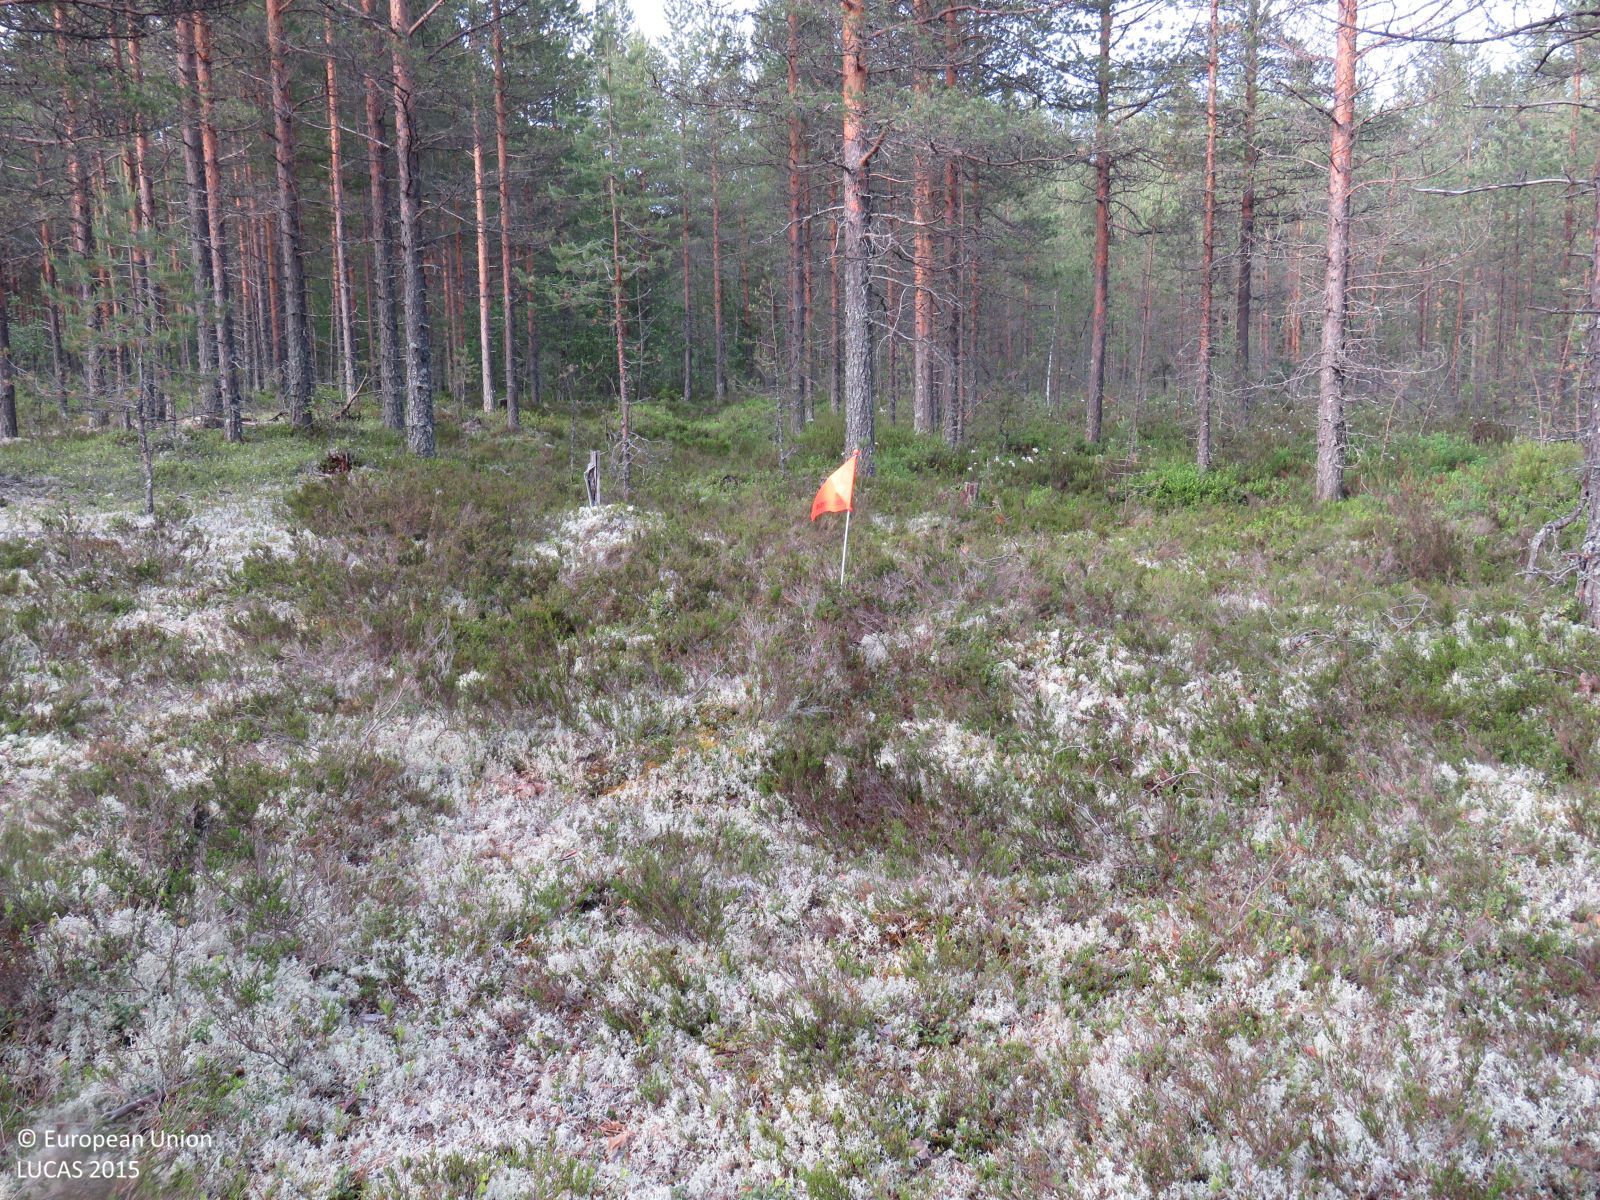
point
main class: Woodland
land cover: Pine dominated coniferous woodland
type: boreal forest
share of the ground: 25 - 50 %
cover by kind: coniferous forest trees 40 %, shrubs 40 %, lichens and mosses 20 %
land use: Forestry
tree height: > 5 m
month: June
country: FI
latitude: 64.0984
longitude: 26.5138
